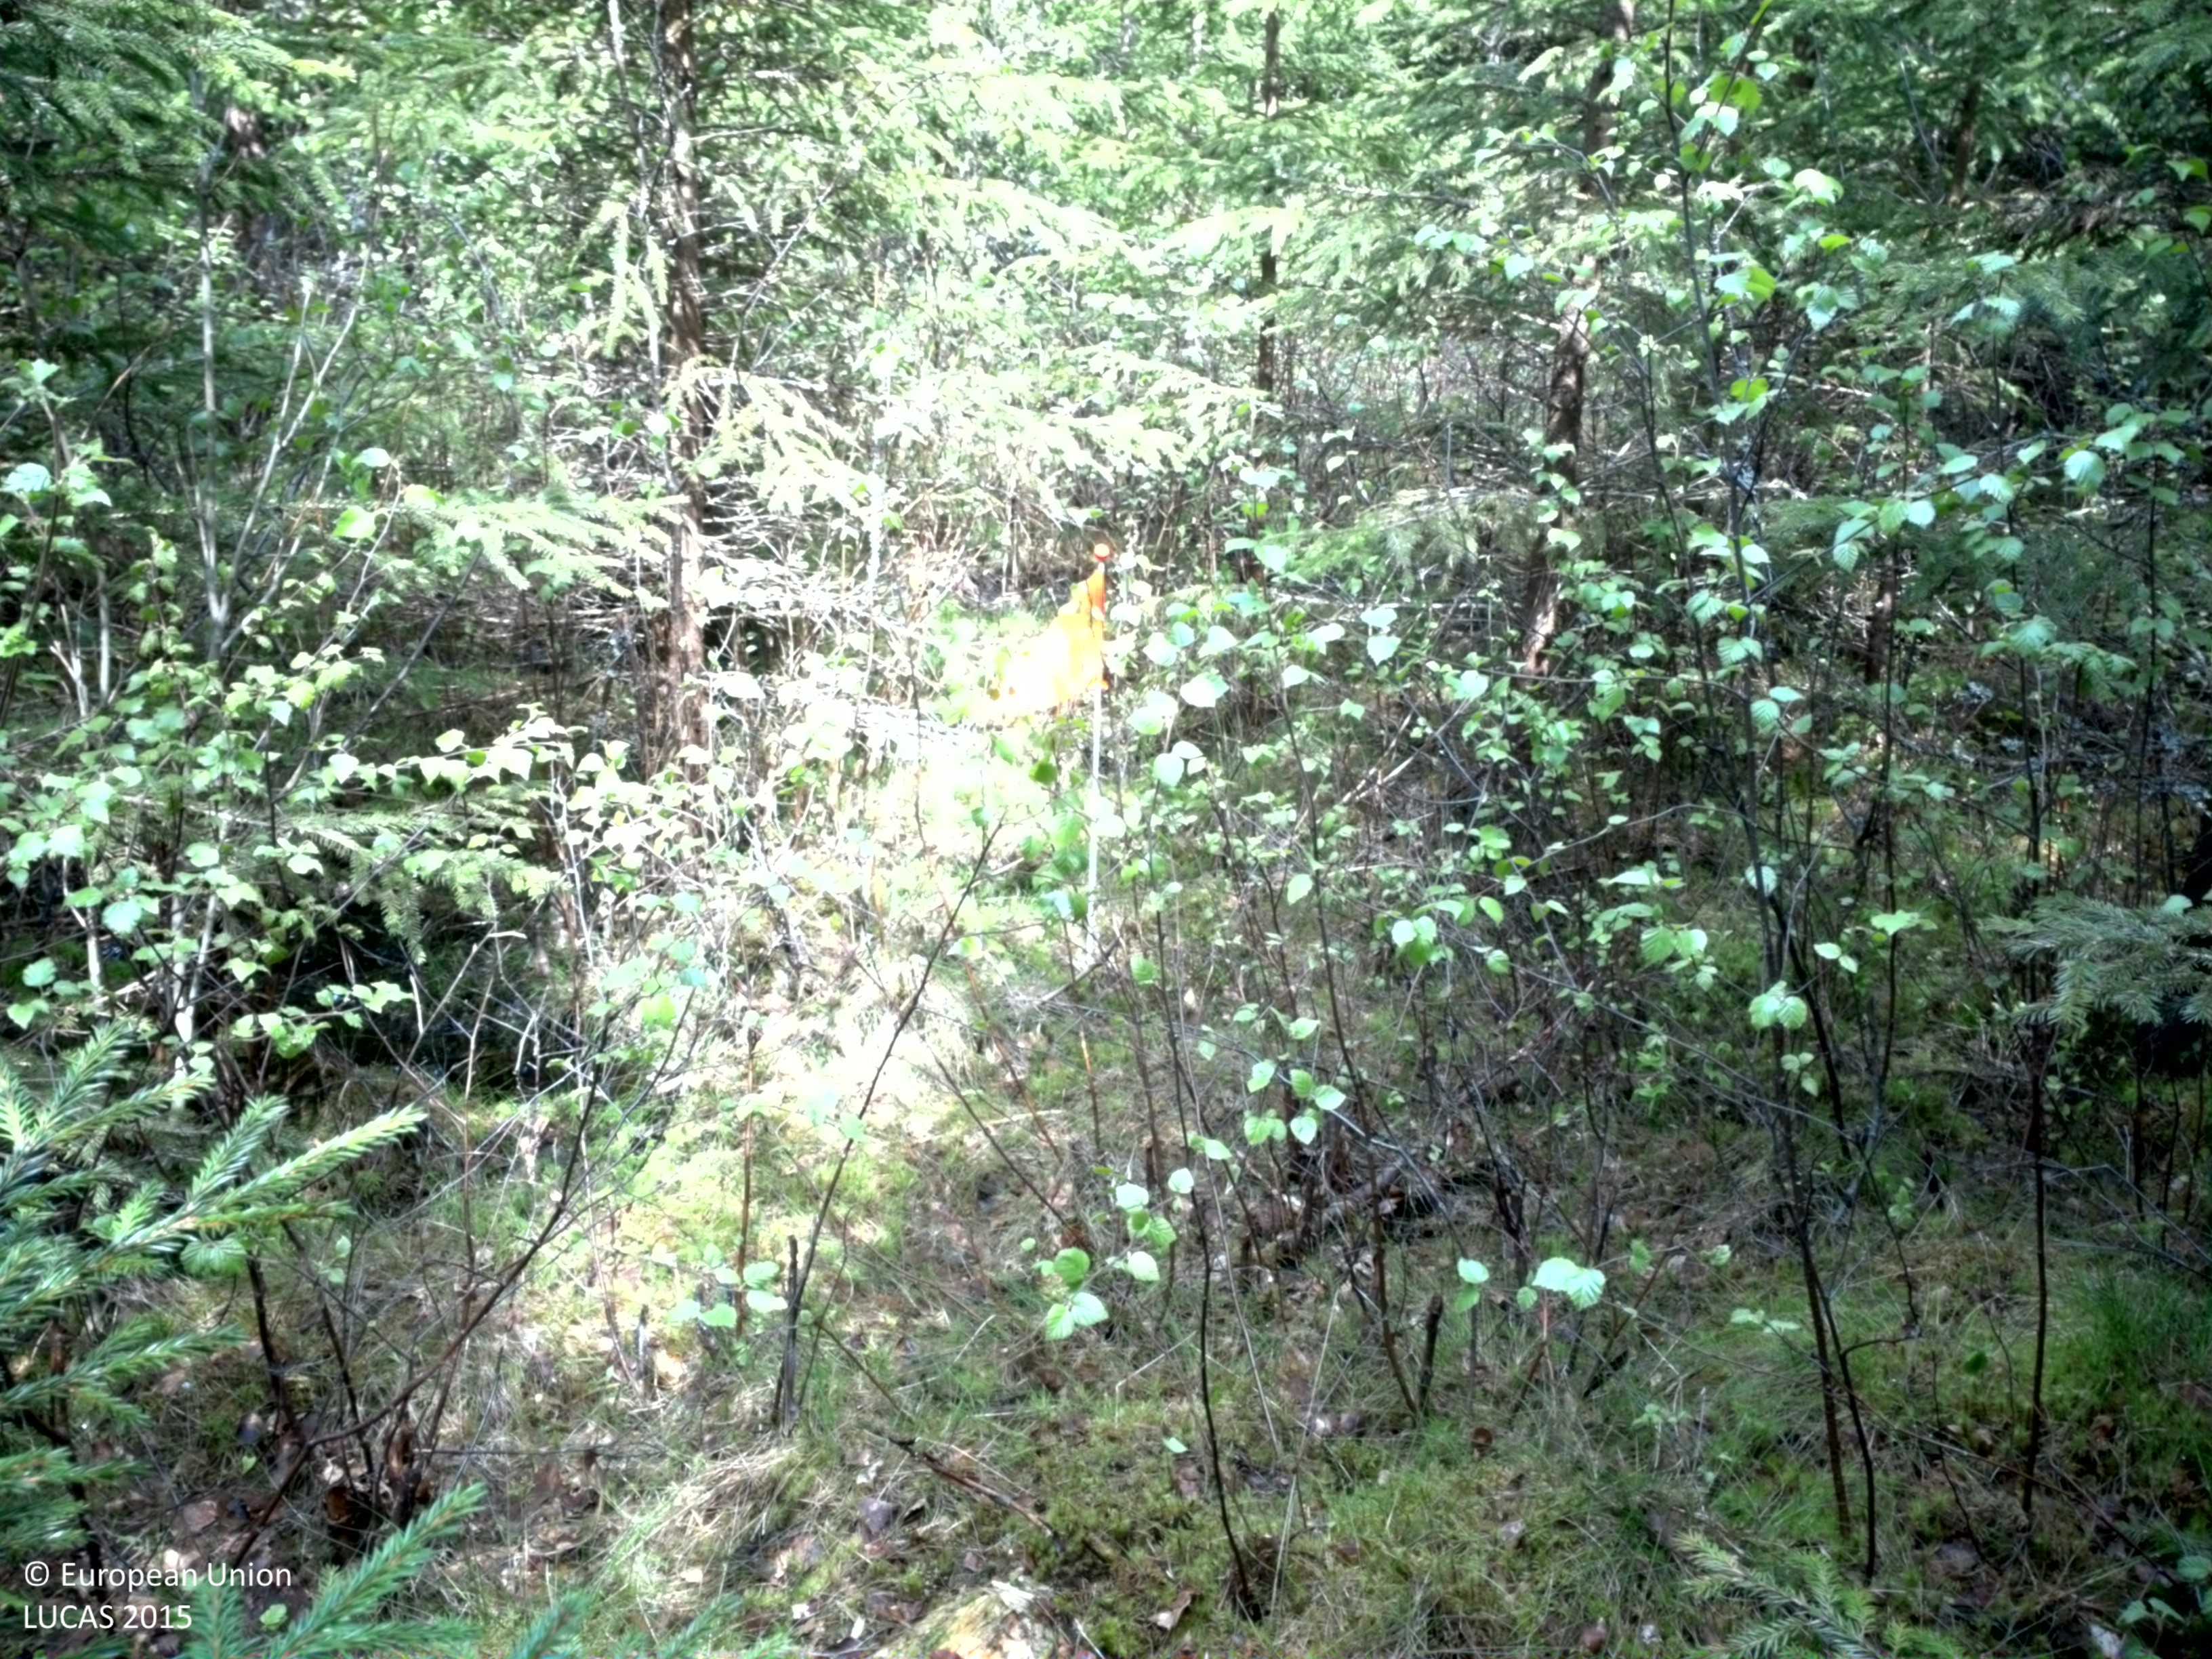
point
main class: Woodland
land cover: Spruce dominated mixed woodland
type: boreal forest
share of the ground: > 75 %
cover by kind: coniferous forest trees 75 %, broadleaved forest trees 25 %
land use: Forestry
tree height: < 5 m
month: May
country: SE
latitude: 56.5752
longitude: 15.4844
